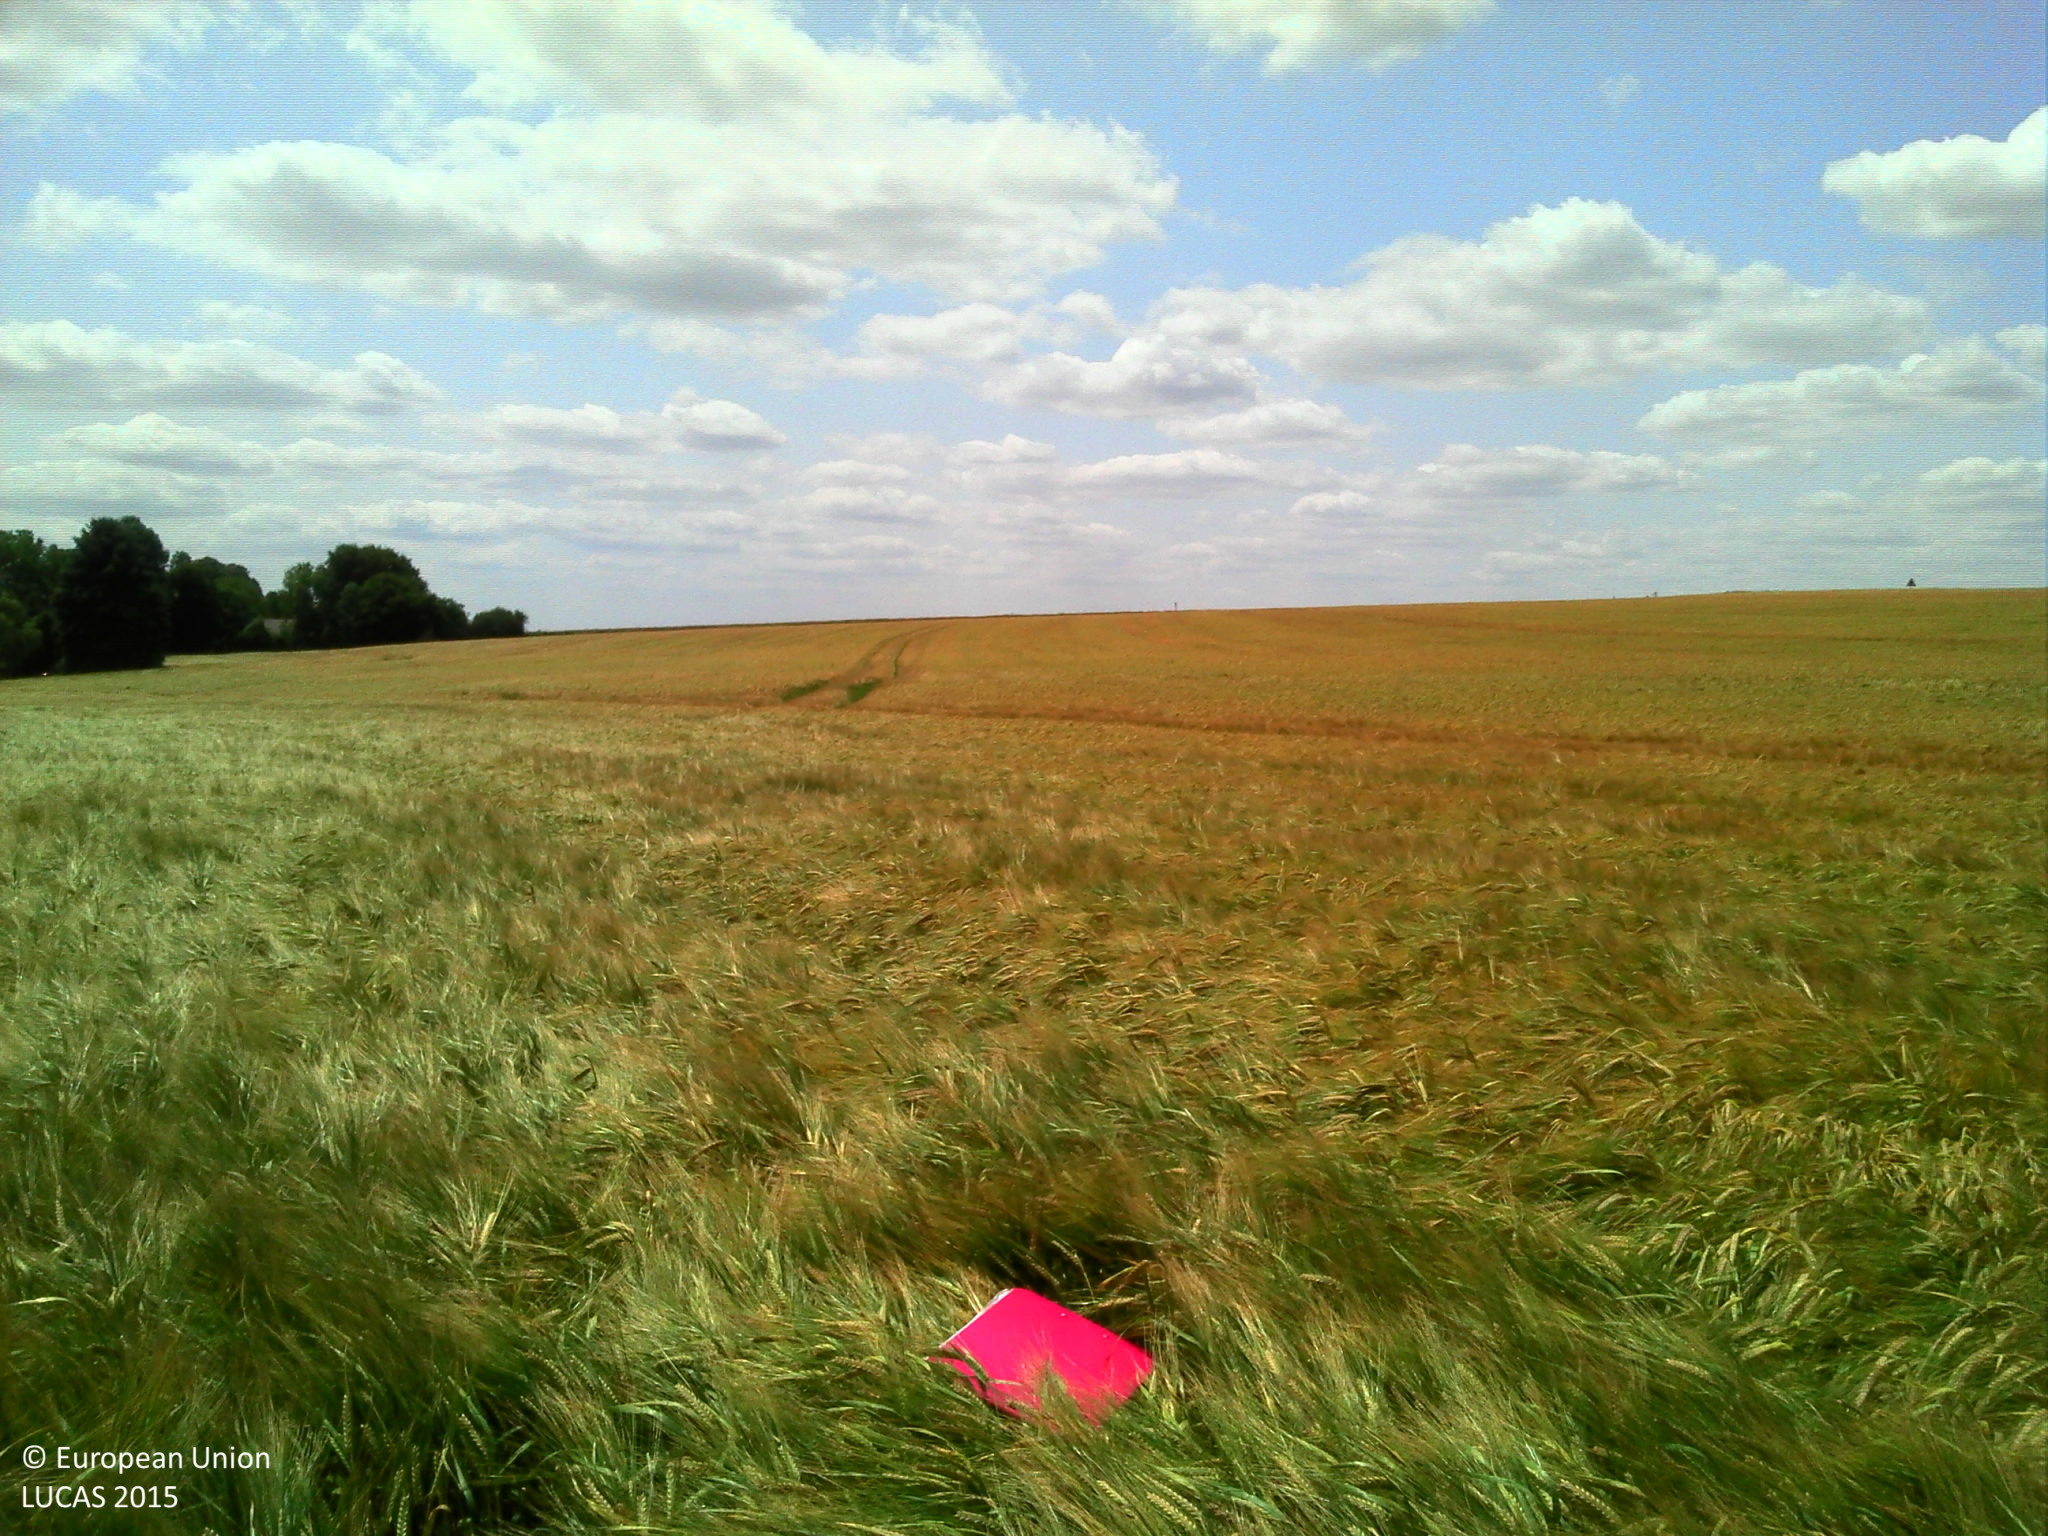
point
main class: Cropland
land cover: Barley
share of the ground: > 75 %
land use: Agriculture (excluding fallow land and kitchen gardens)
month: July
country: FR
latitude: 49.2843
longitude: 1.9426
